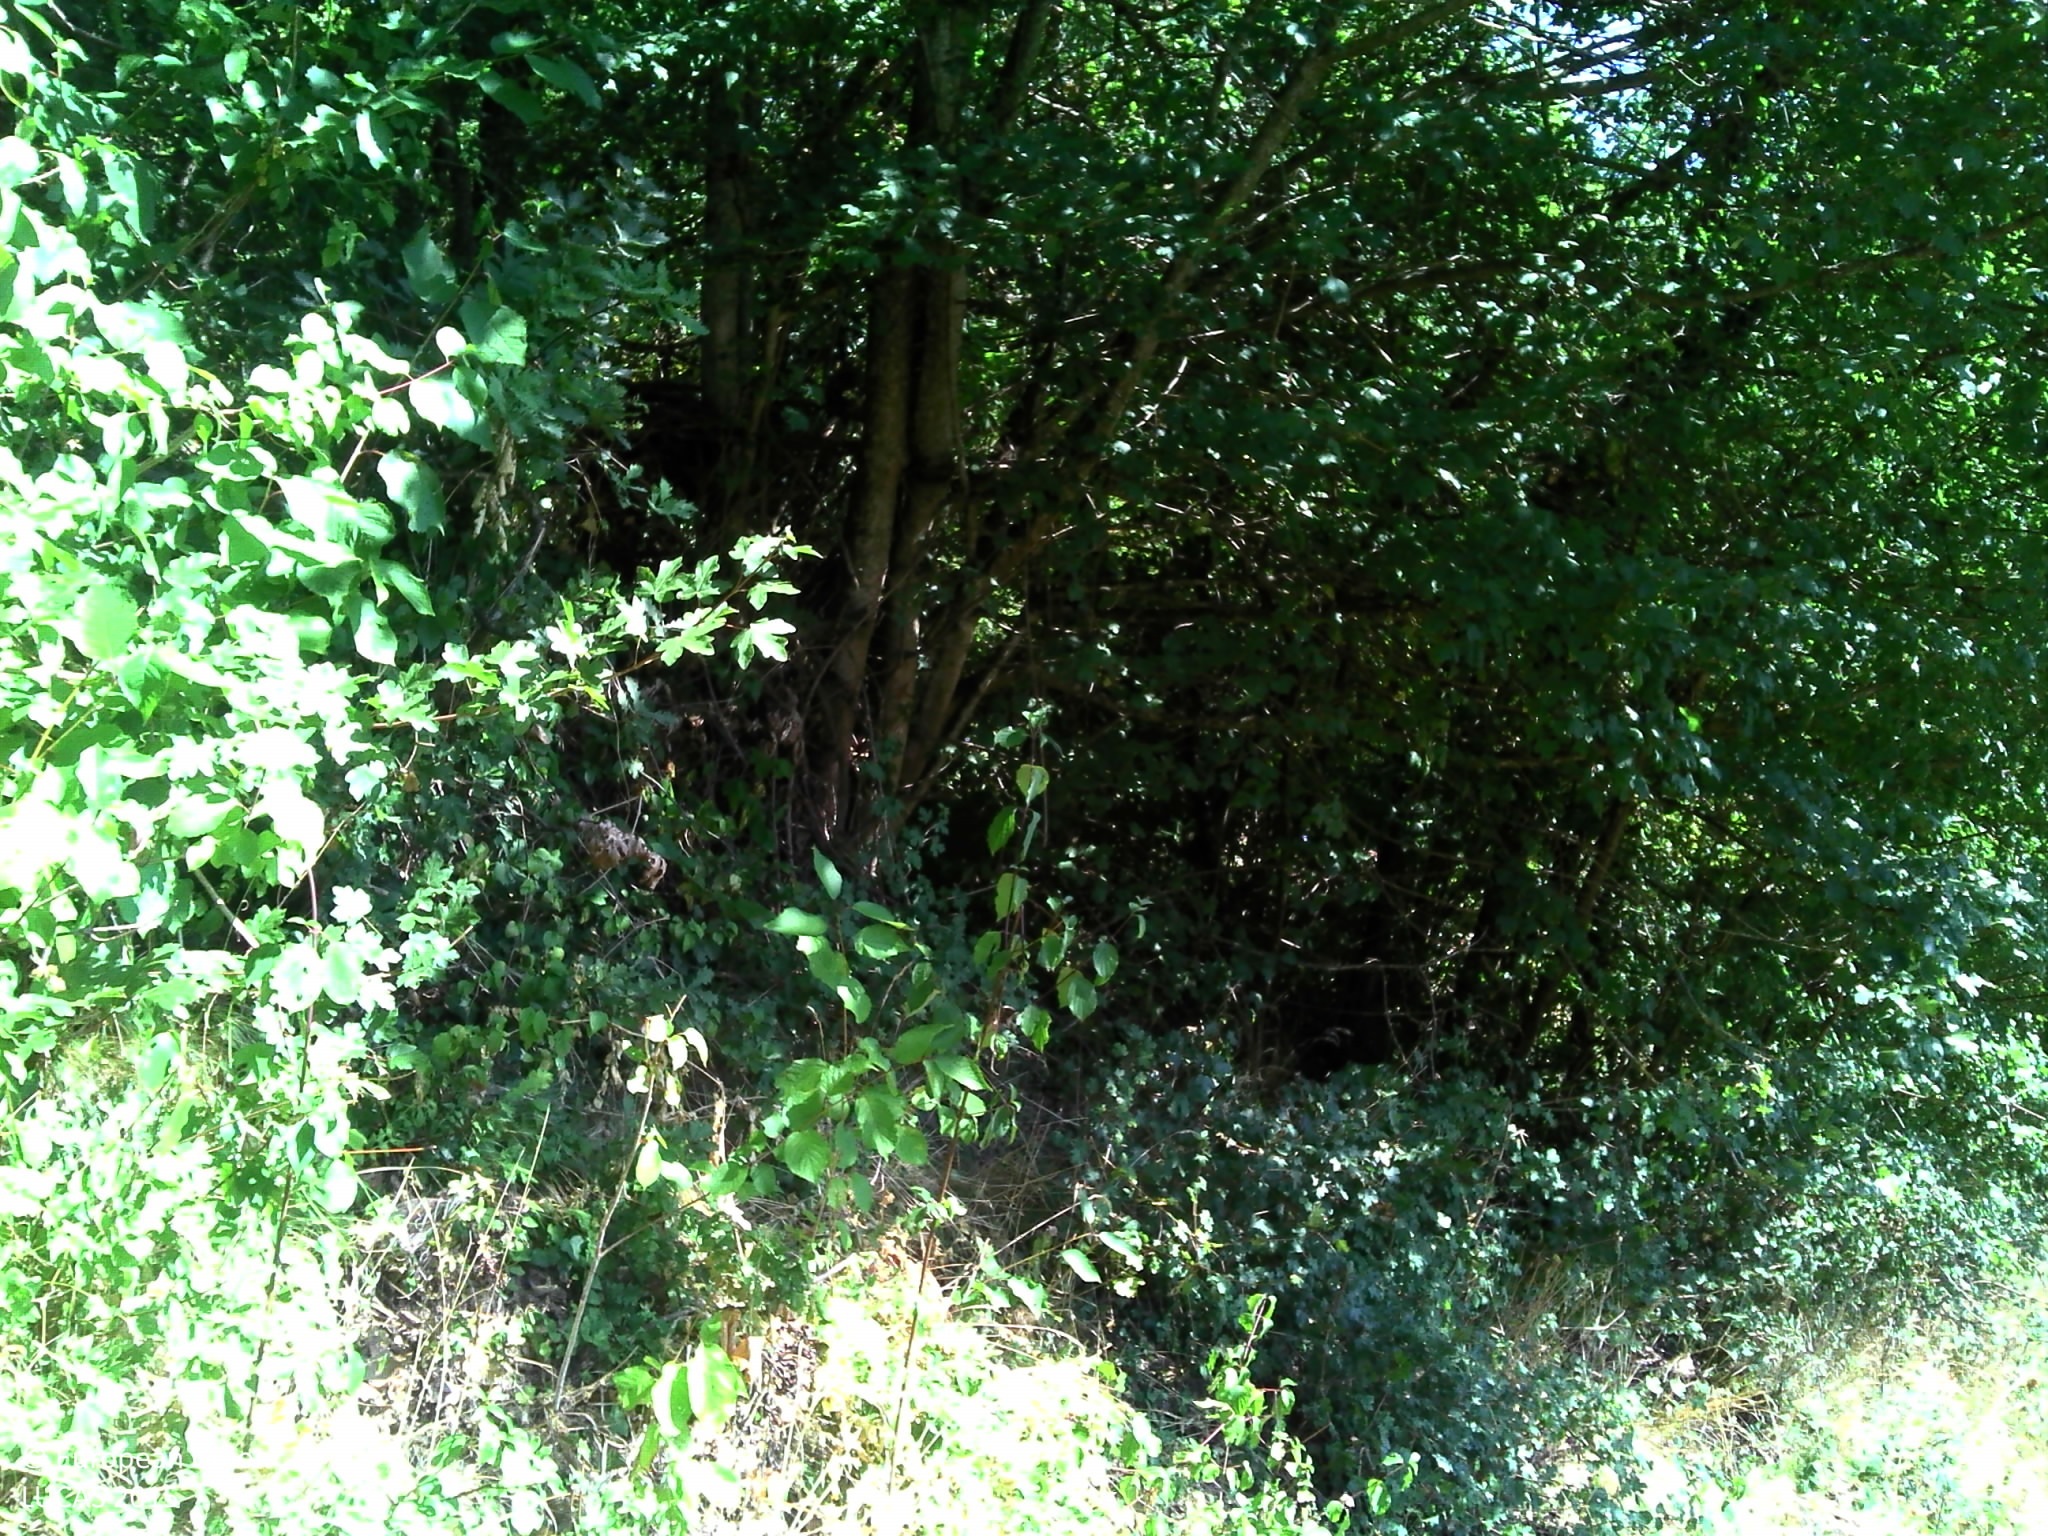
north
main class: Shrubland
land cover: Shrubland without tree cover
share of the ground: > 75 %
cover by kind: herbaceous plants 65 %, shrubs 35 %
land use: Agriculture (excluding fallow land and kitchen gardens)
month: July
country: FR
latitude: 45.2982
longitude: 5.4526
